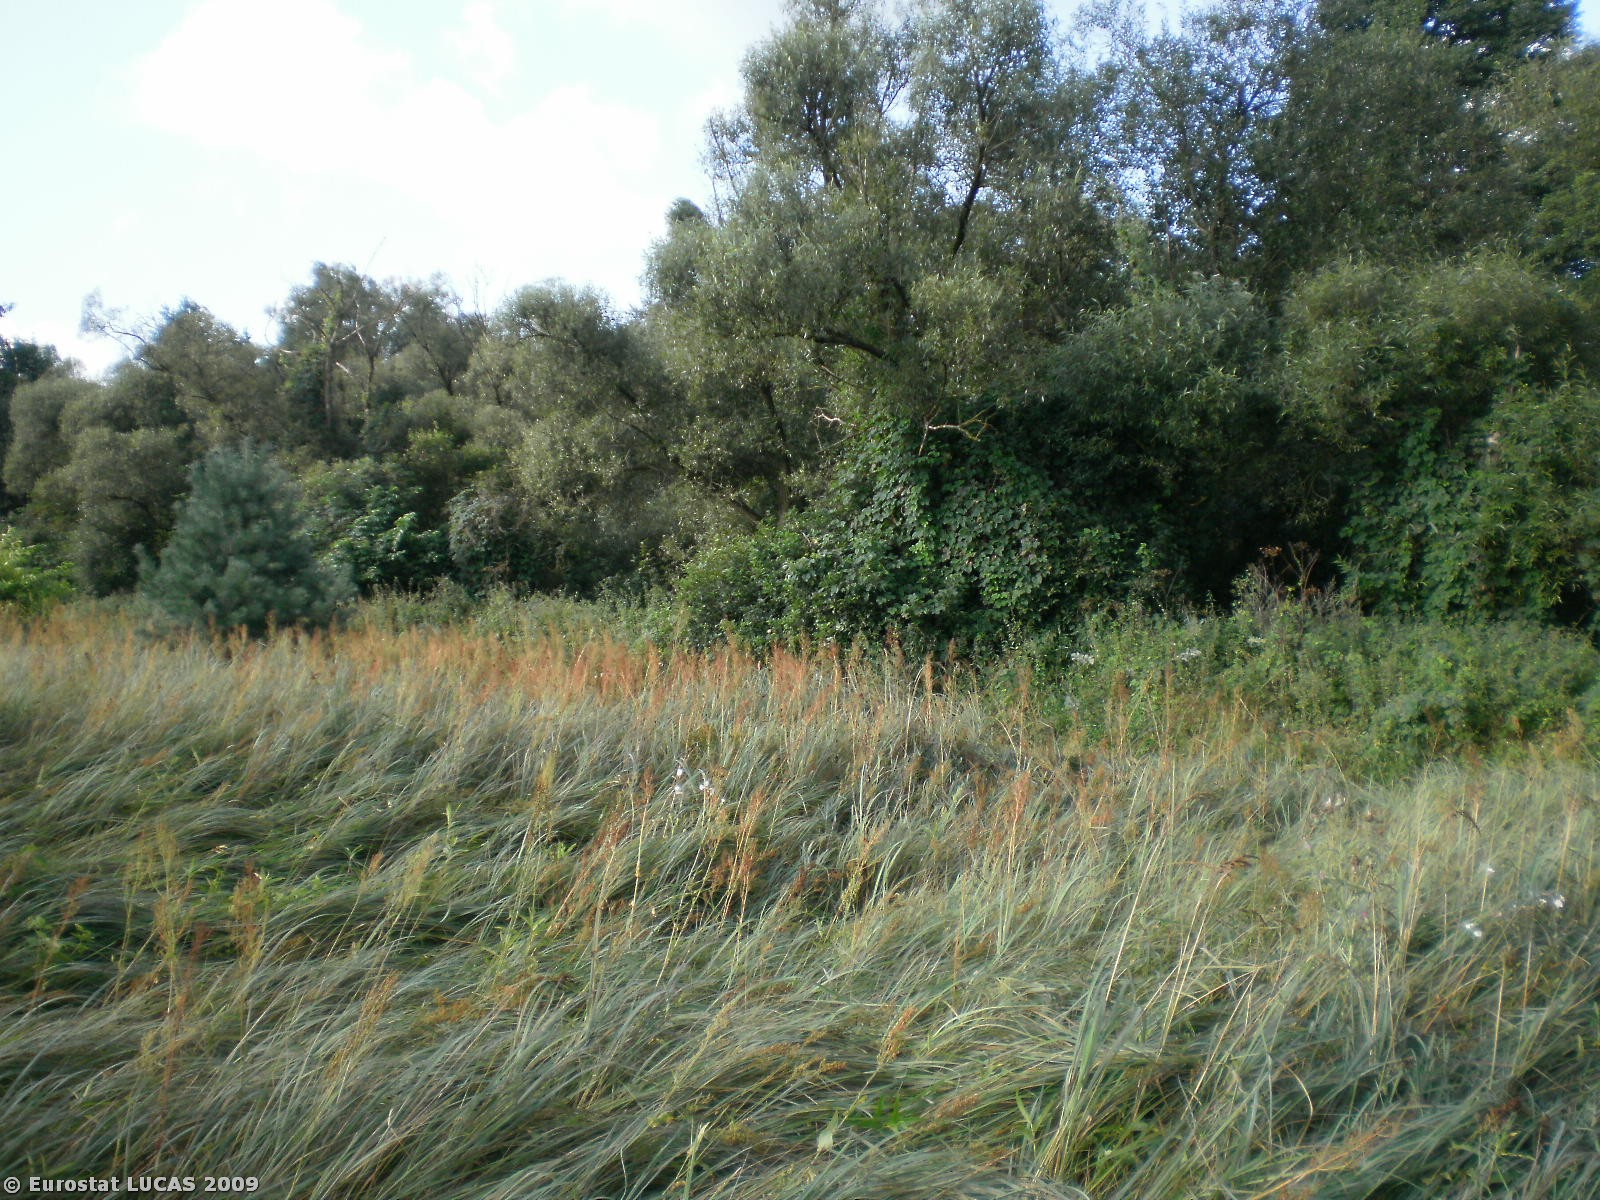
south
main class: Grassland
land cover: Grassland with sparse tree/shrub cover
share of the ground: > 75 %
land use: Nature reserves
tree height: > 5 m
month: August
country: PL
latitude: 52.7232
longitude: 21.1355
